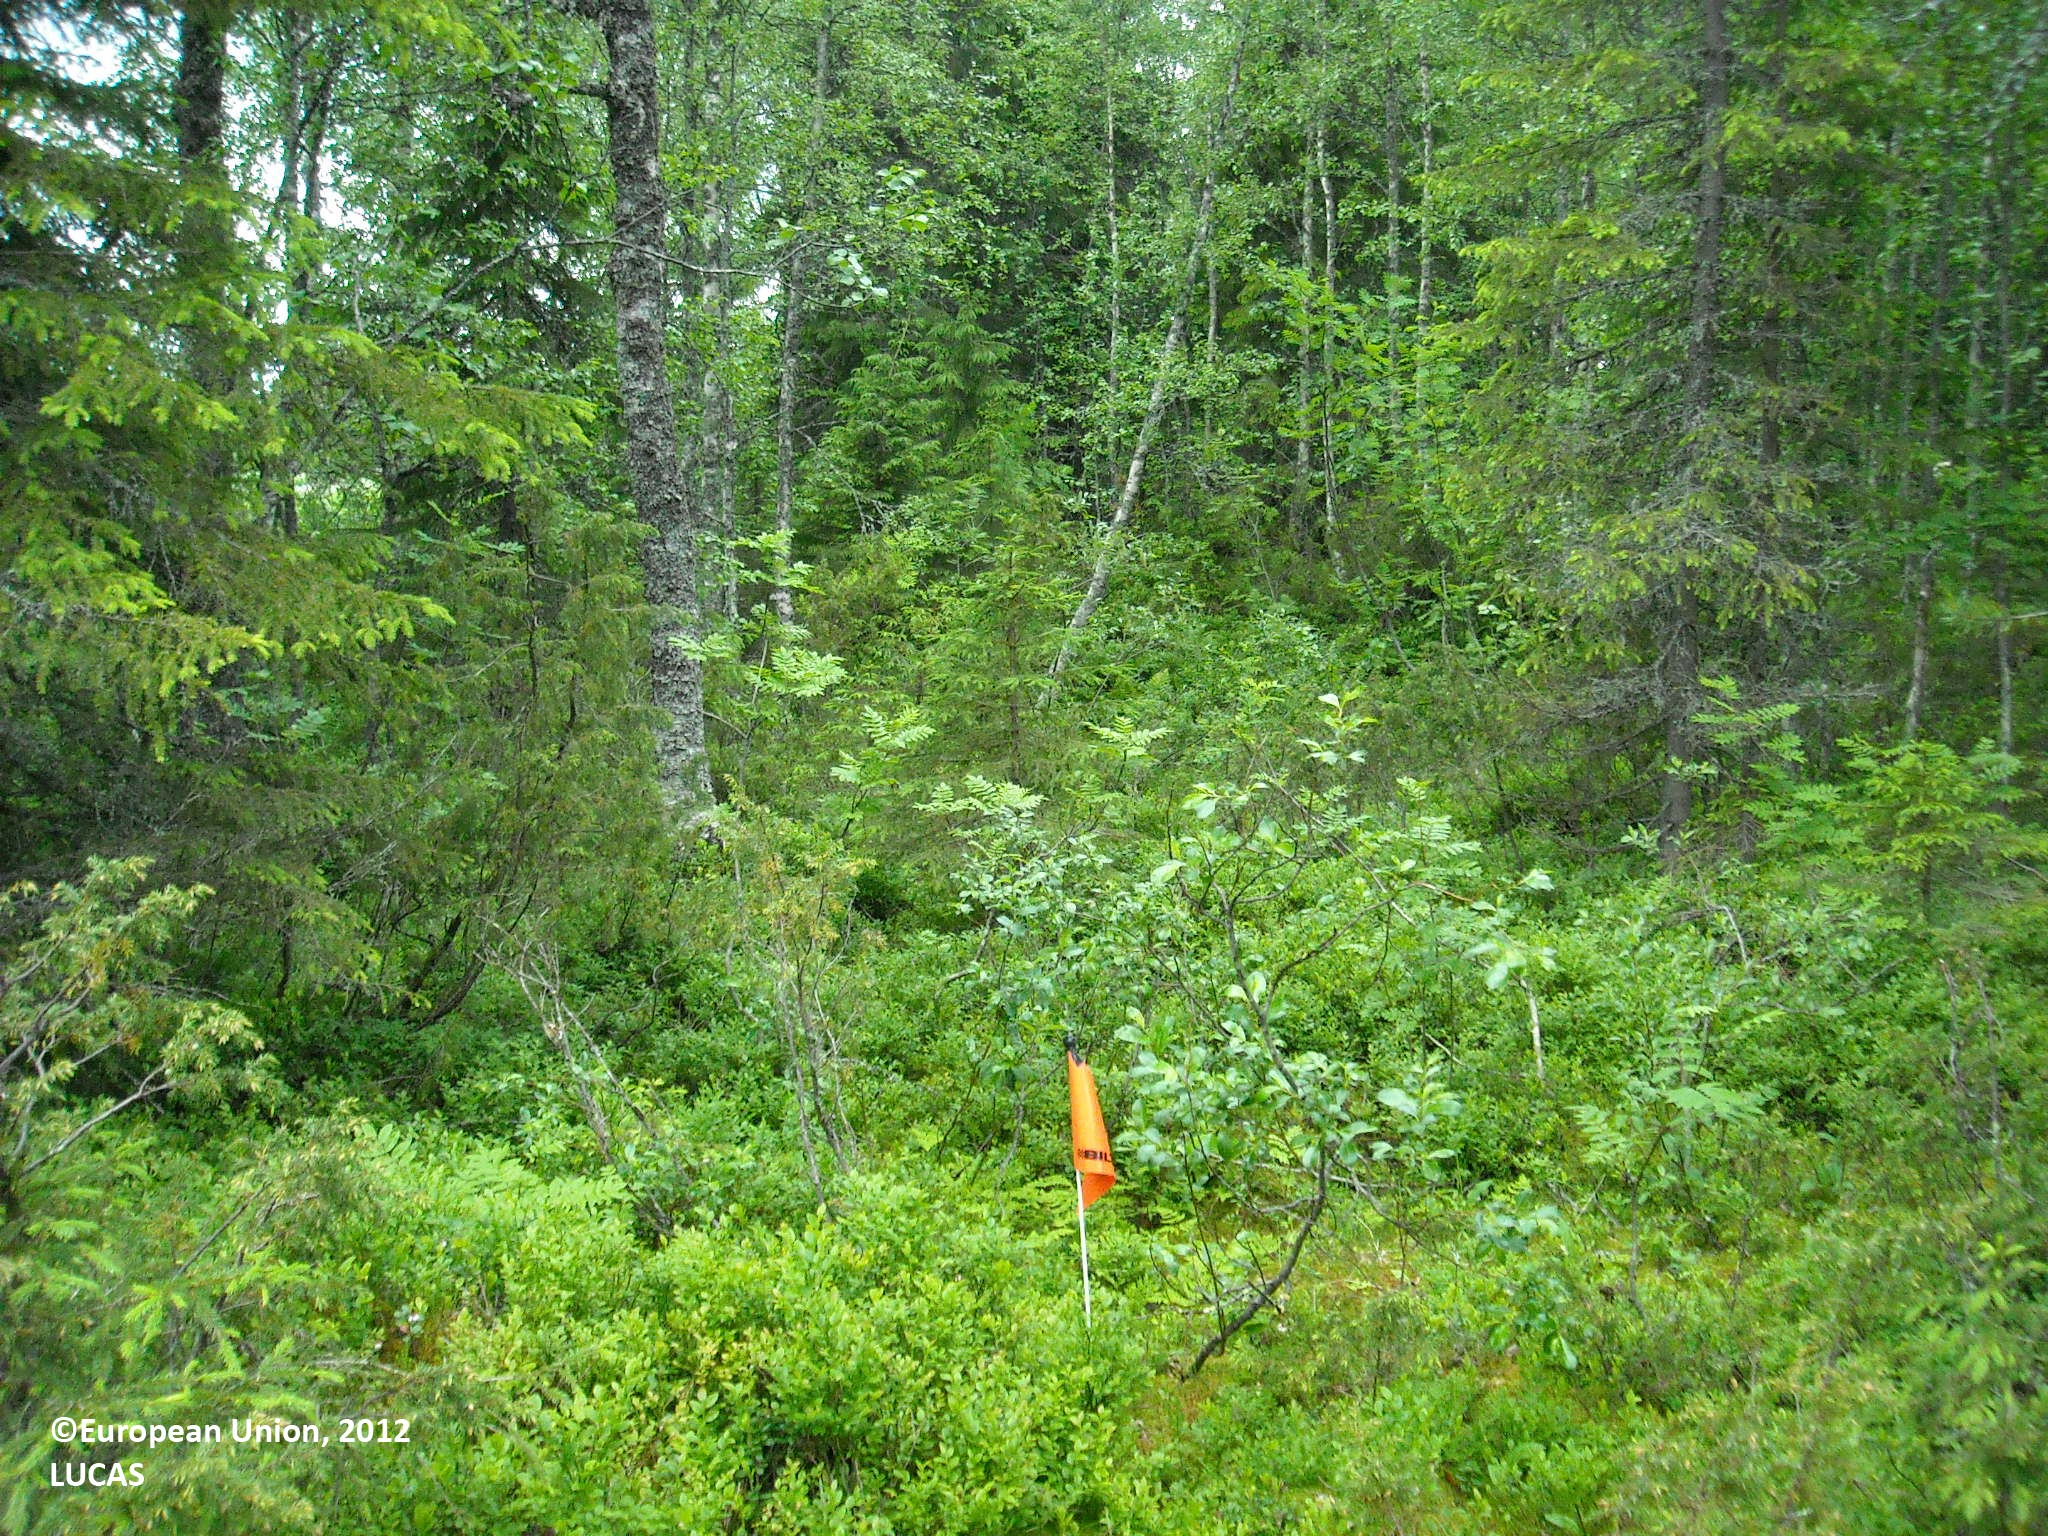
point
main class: Woodland
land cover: Spruce dominated mixed woodland
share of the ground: > 75 %
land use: Forestry
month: July
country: FI
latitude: 64.9894
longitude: 27.8917
